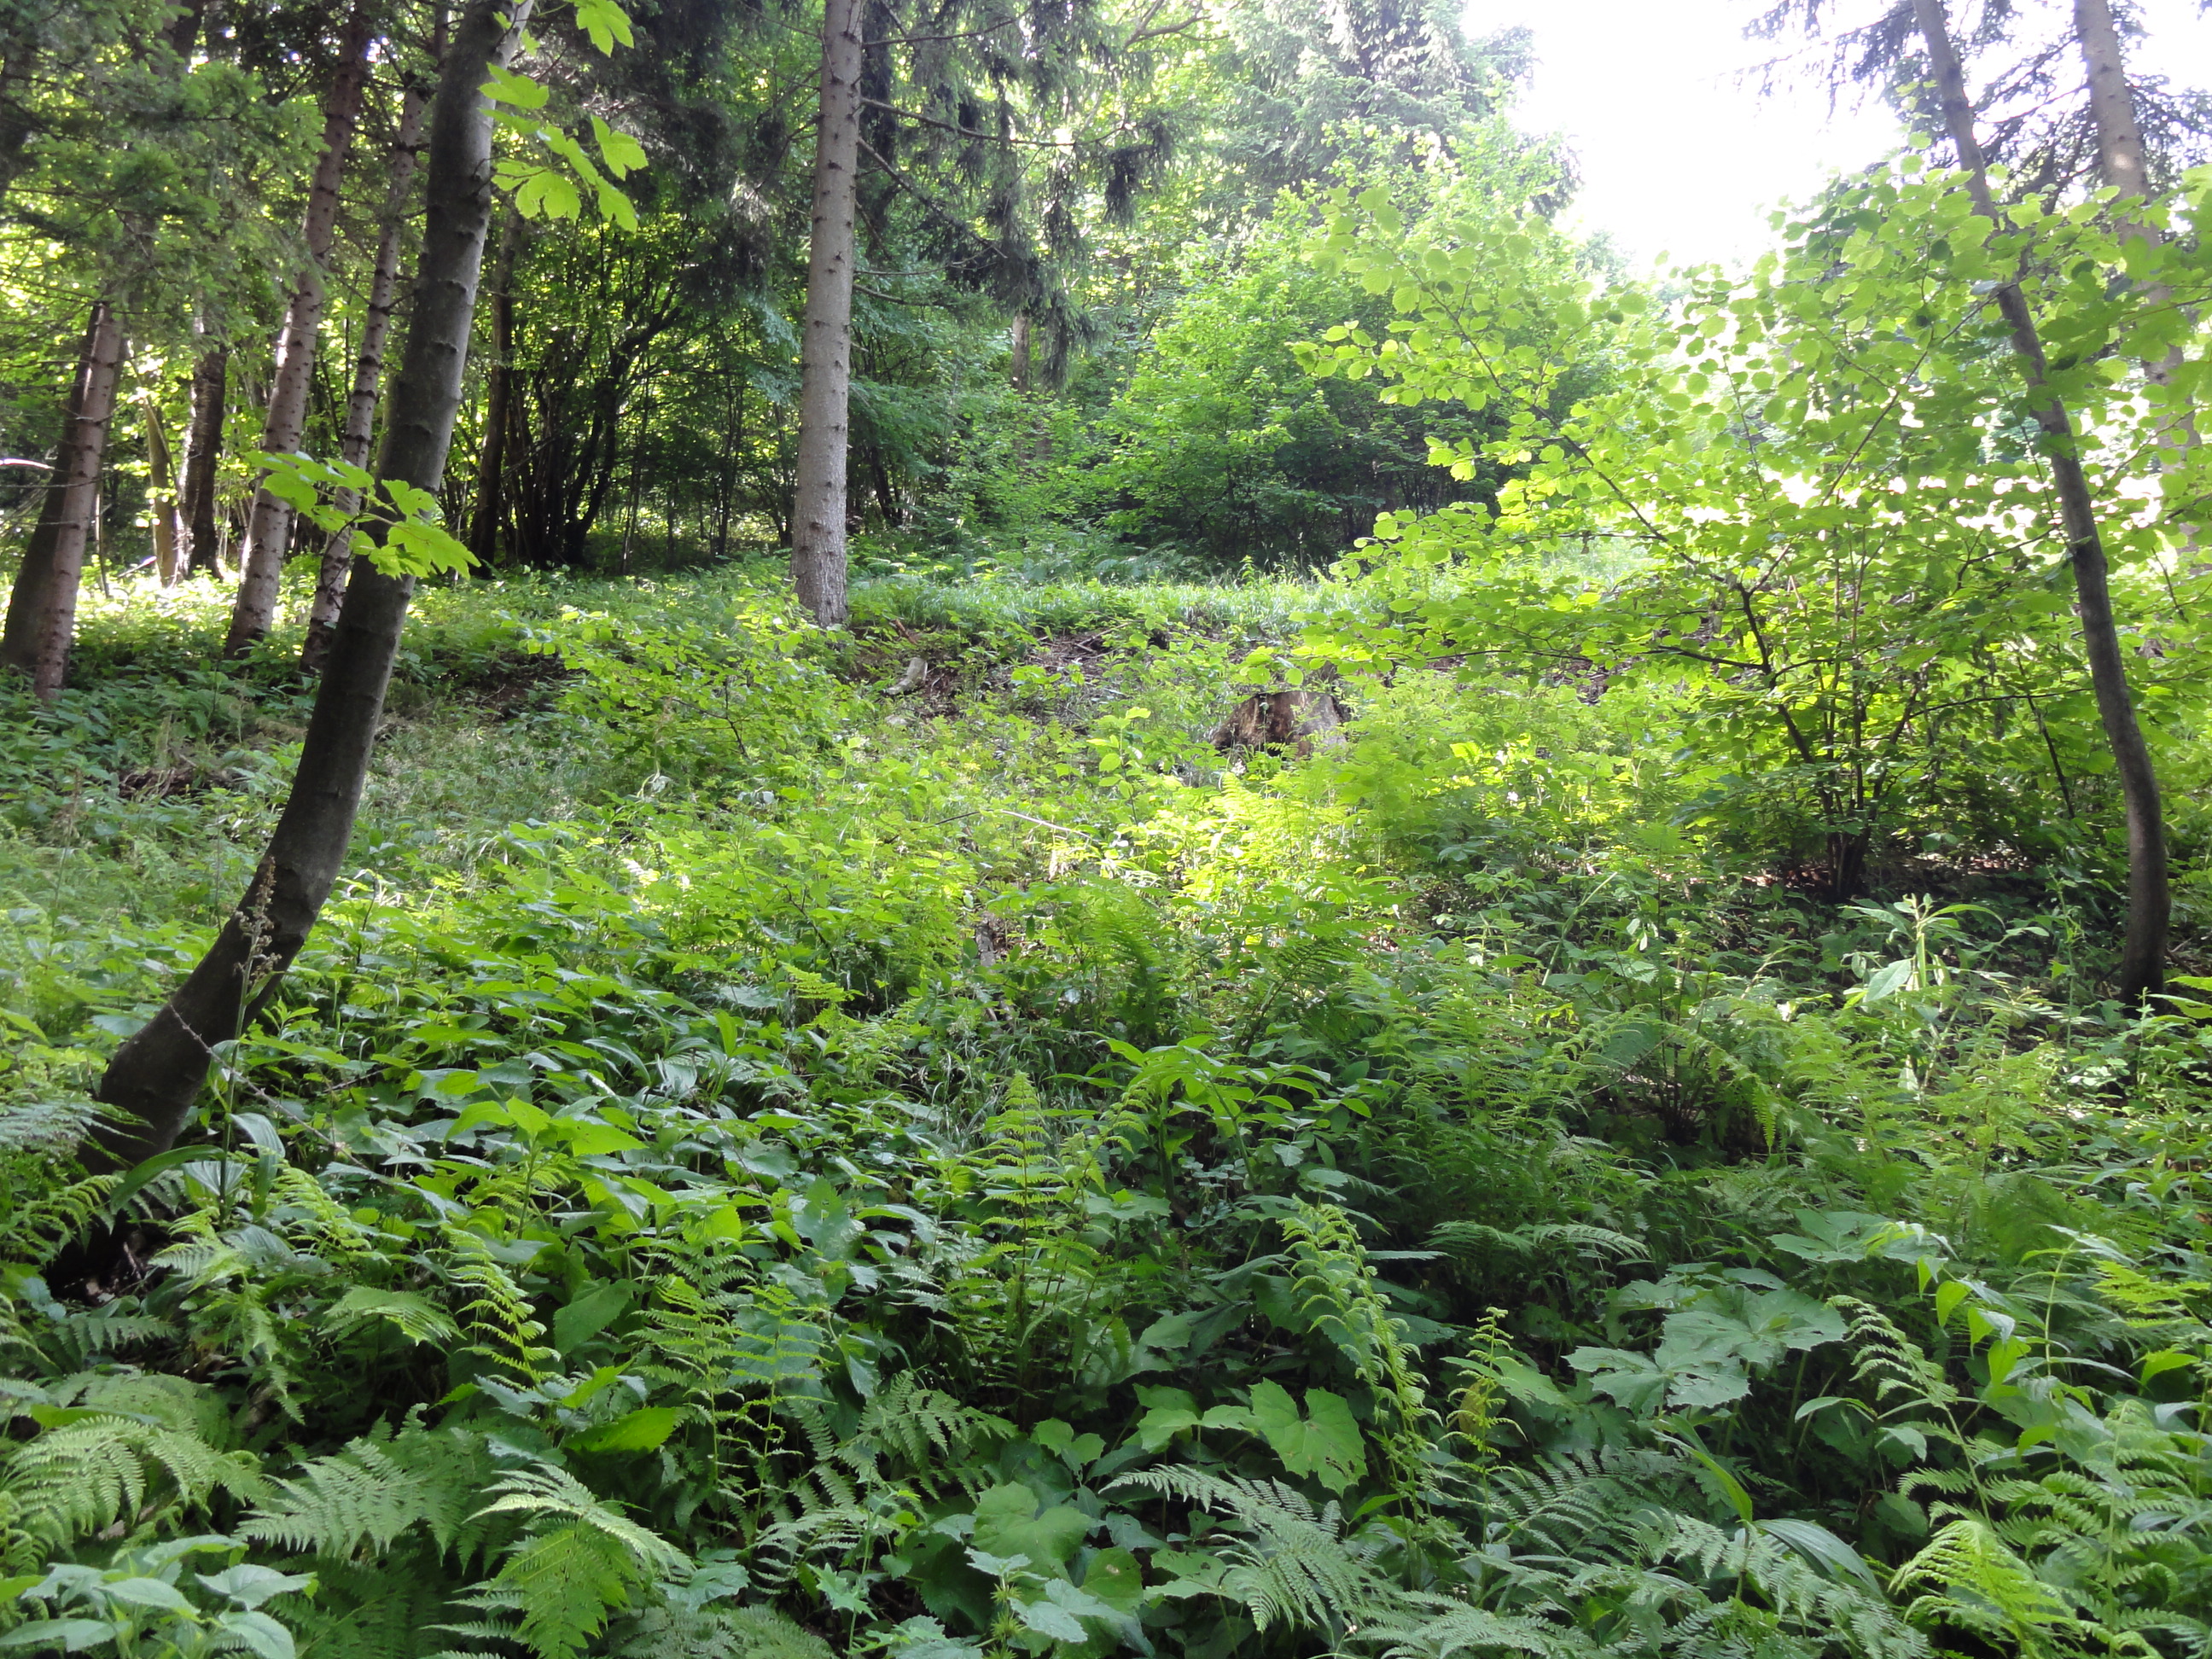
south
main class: Woodland
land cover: Spruce dominated mixed woodland
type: mountainous beech forest
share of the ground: > 75 %
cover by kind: coniferous forest trees 50 %, broadleaved forest trees 50 %
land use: Forestry
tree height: > 5 m
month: June
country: SI
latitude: 46.2132
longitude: 15.0656
